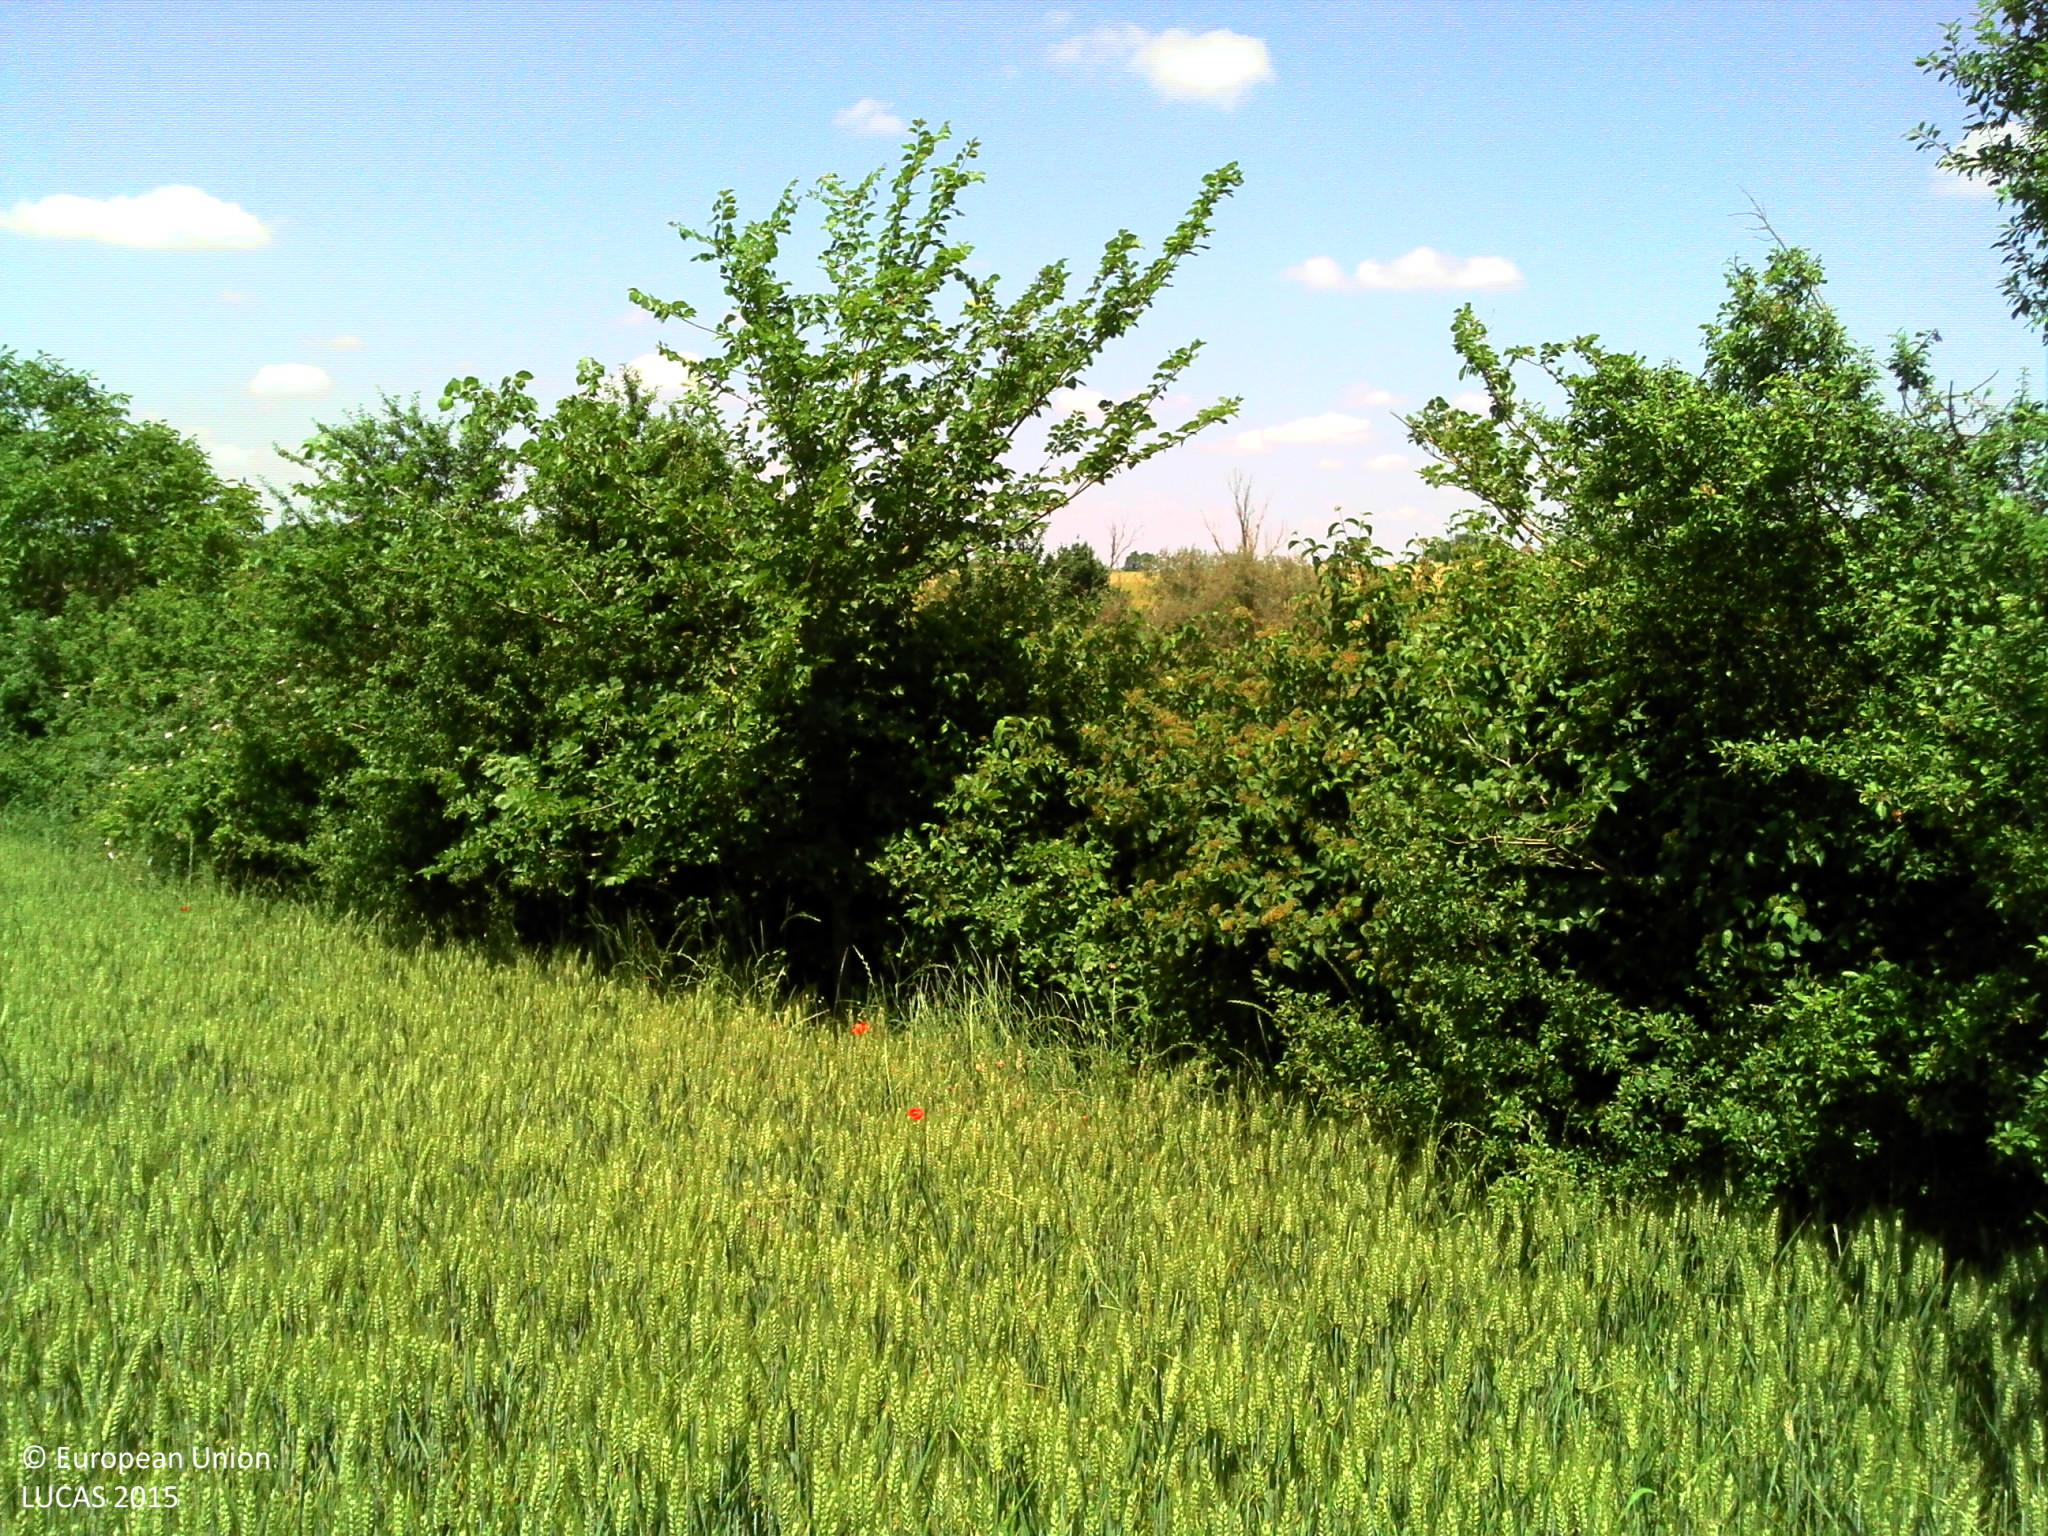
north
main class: Cropland
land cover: Common wheat
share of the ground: > 75 %
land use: Agriculture (excluding fallow land and kitchen gardens)
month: June
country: FR
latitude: 43.5937
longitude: 0.7711
